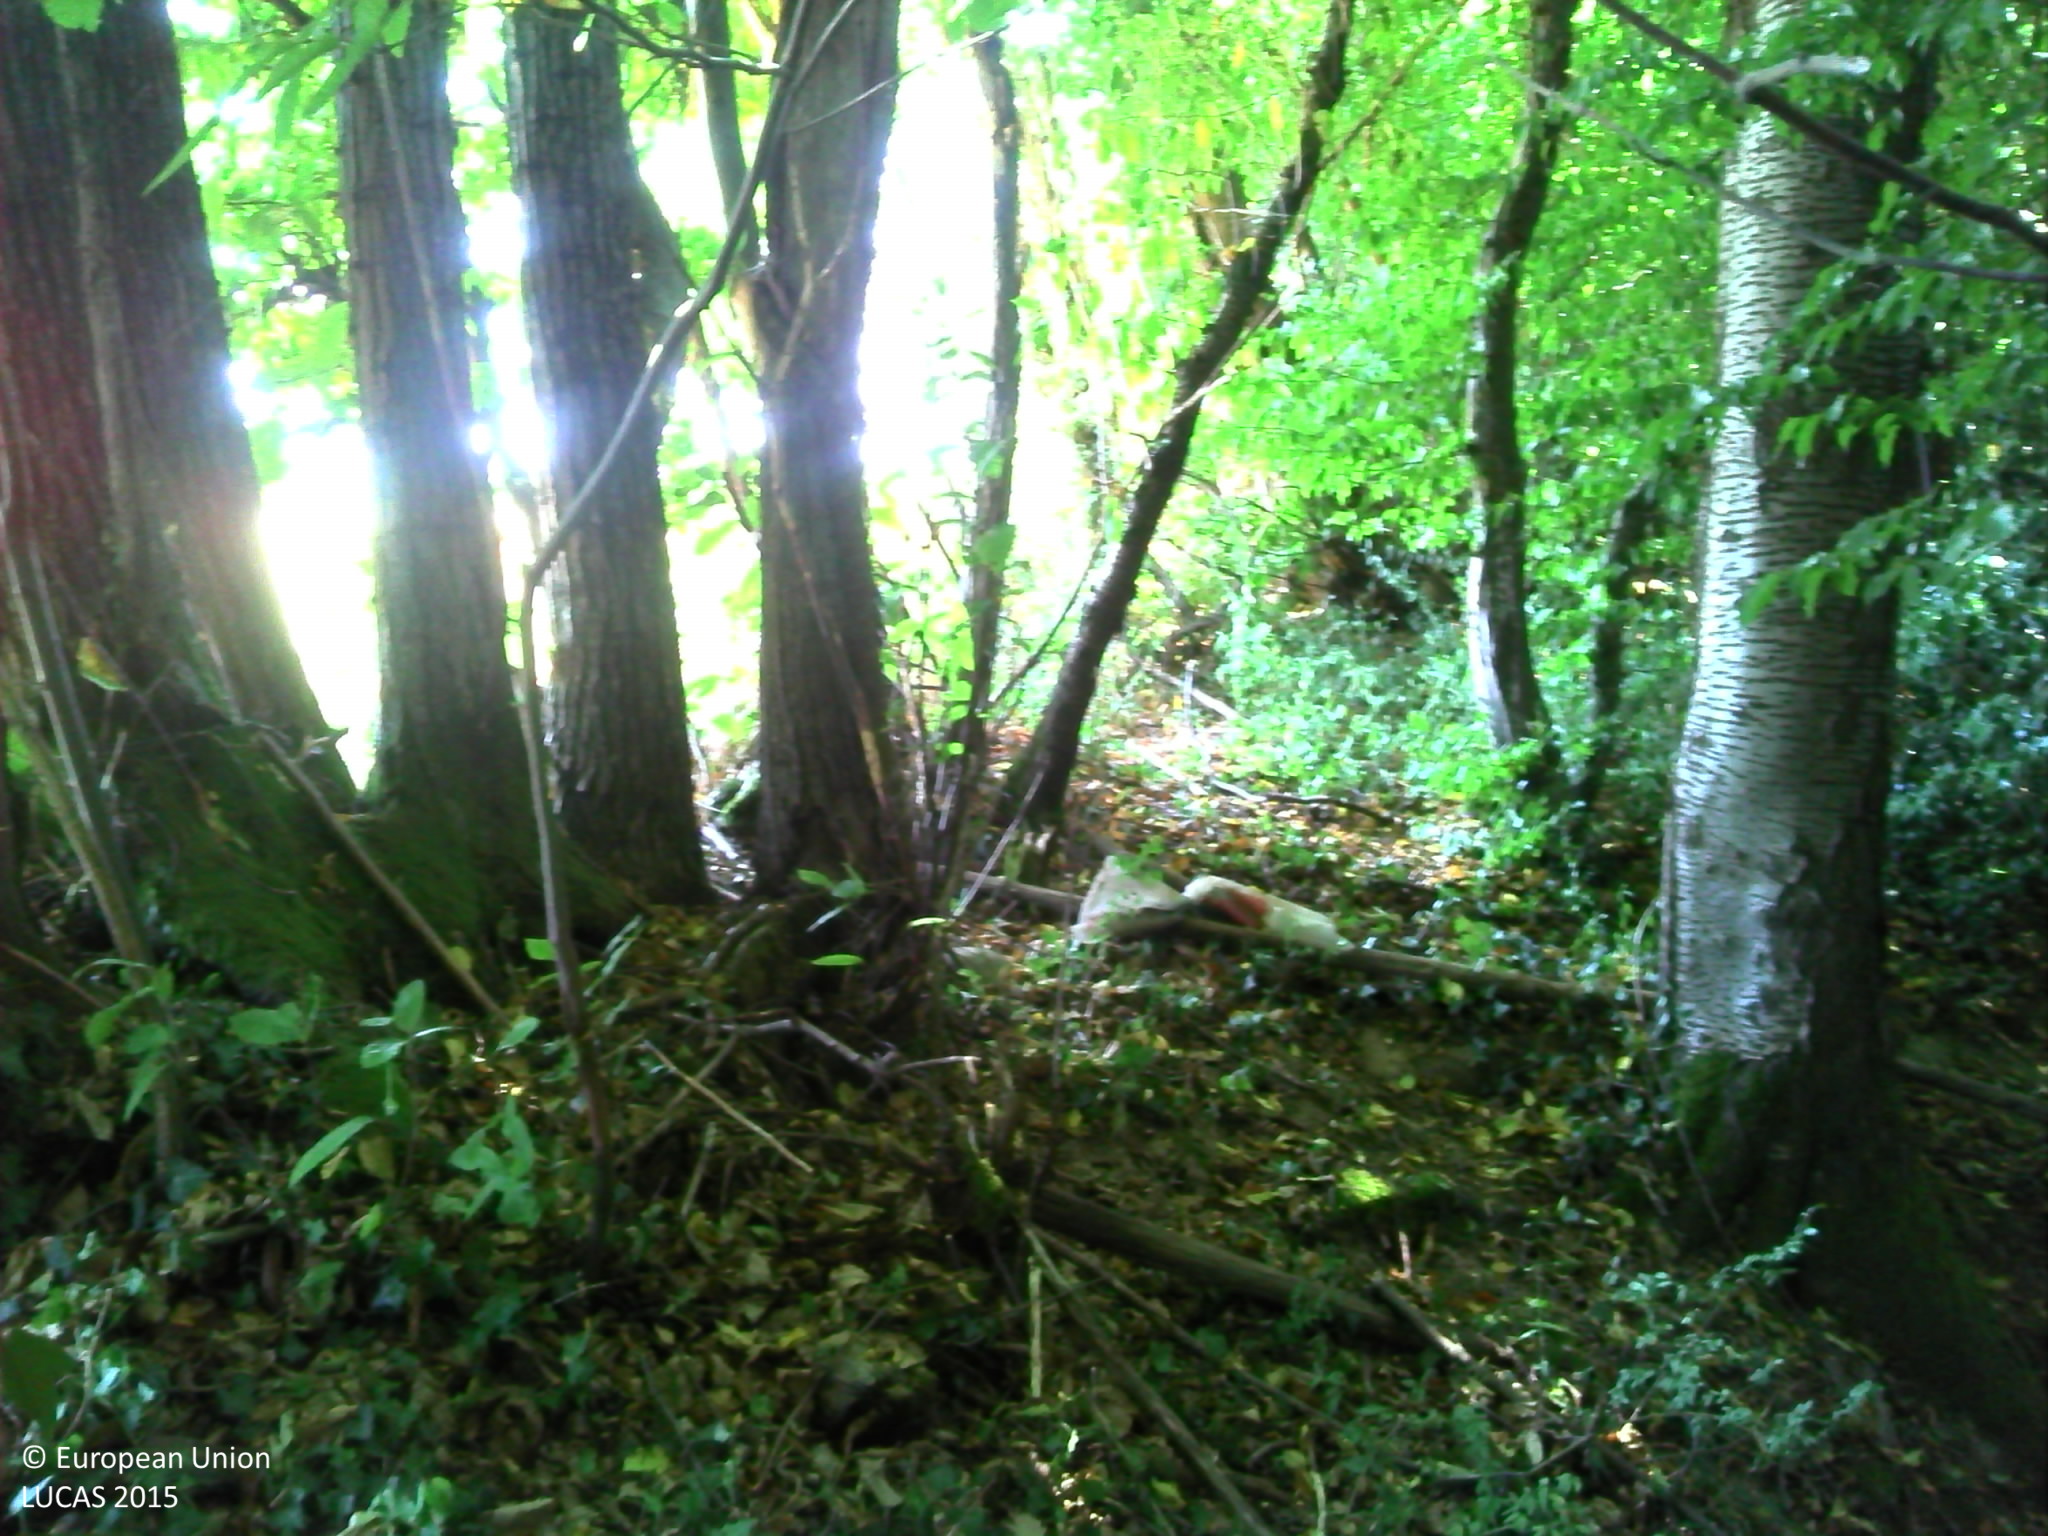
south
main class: Woodland
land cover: Broadleaved woodland
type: thermophilous deciduous forest
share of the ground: > 75 %
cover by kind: broadleaved forest trees 90 %, herbaceous plants 10 %
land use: Semi-natural and natural areas not in use
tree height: > 5 m
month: July
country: FR
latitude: 45.3733
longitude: 5.1142
